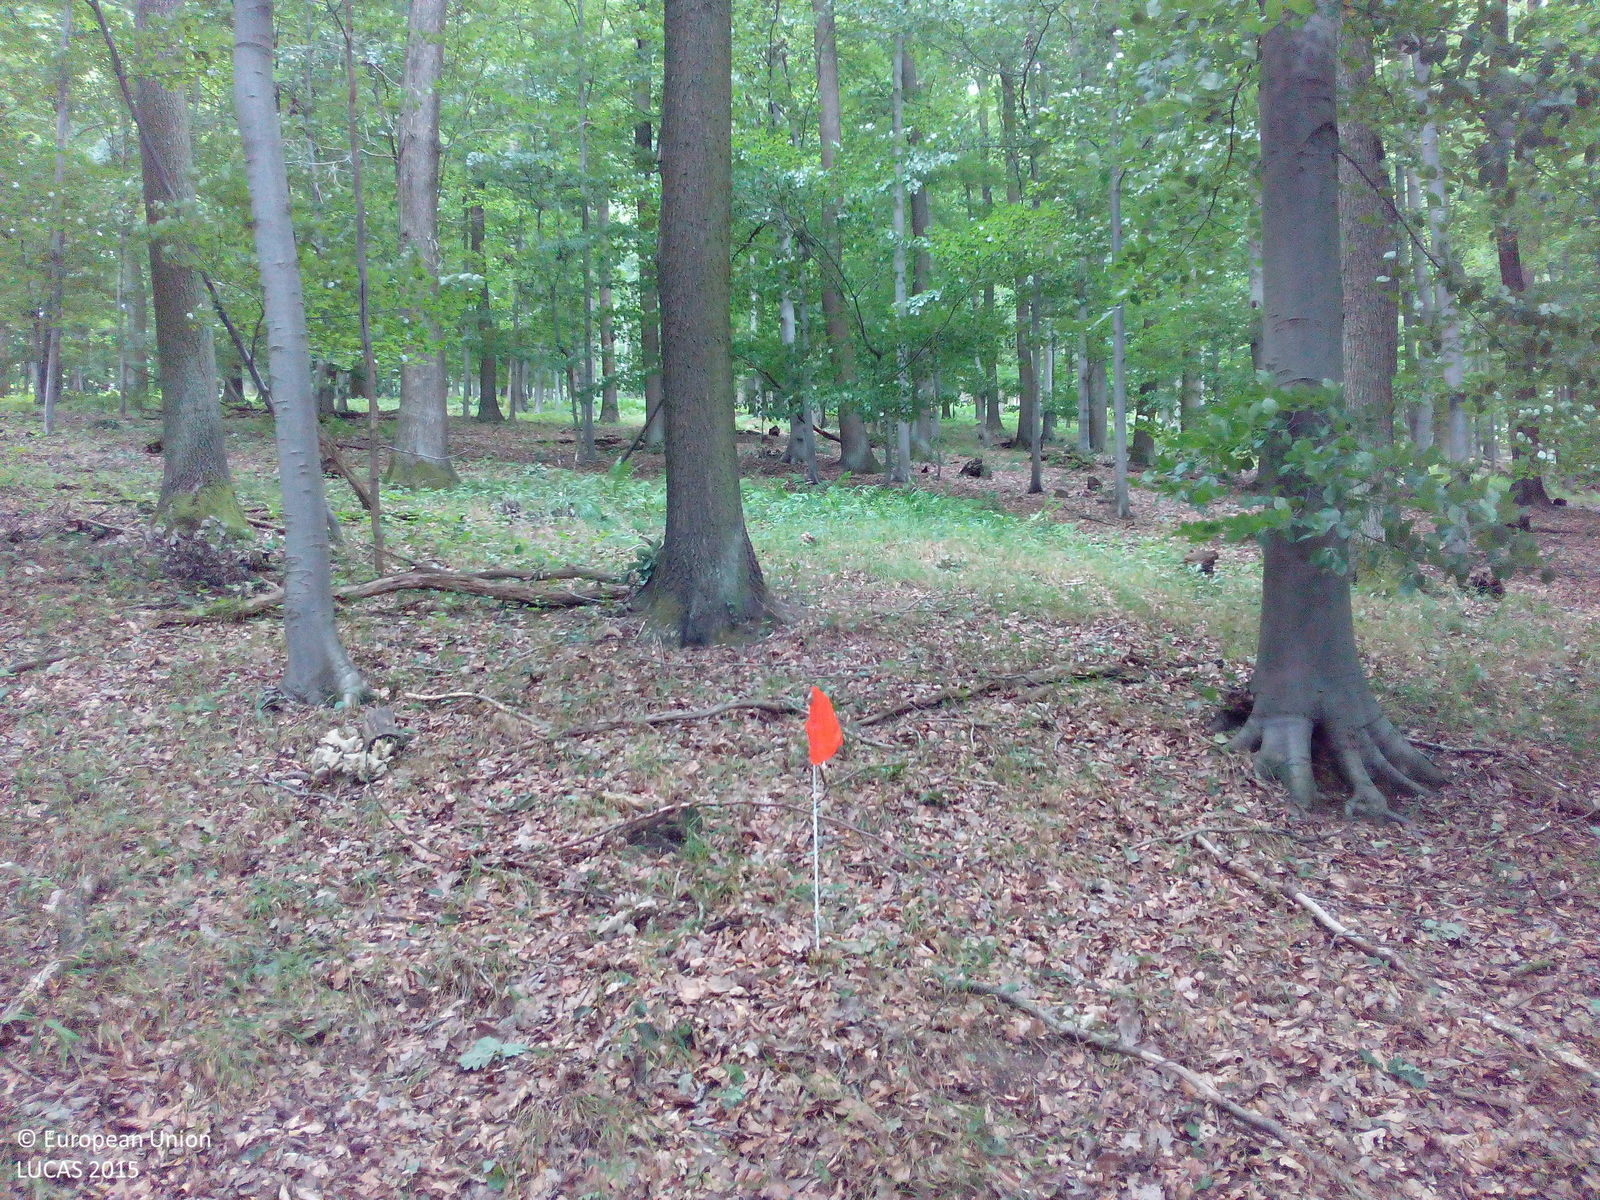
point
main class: Woodland
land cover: Broadleaved woodland
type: beech forest
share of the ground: > 75 %
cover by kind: broadleaved forest trees 100 %
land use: Forestry
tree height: > 5 m
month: July
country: DE
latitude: 51.7843
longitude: 9.9565
